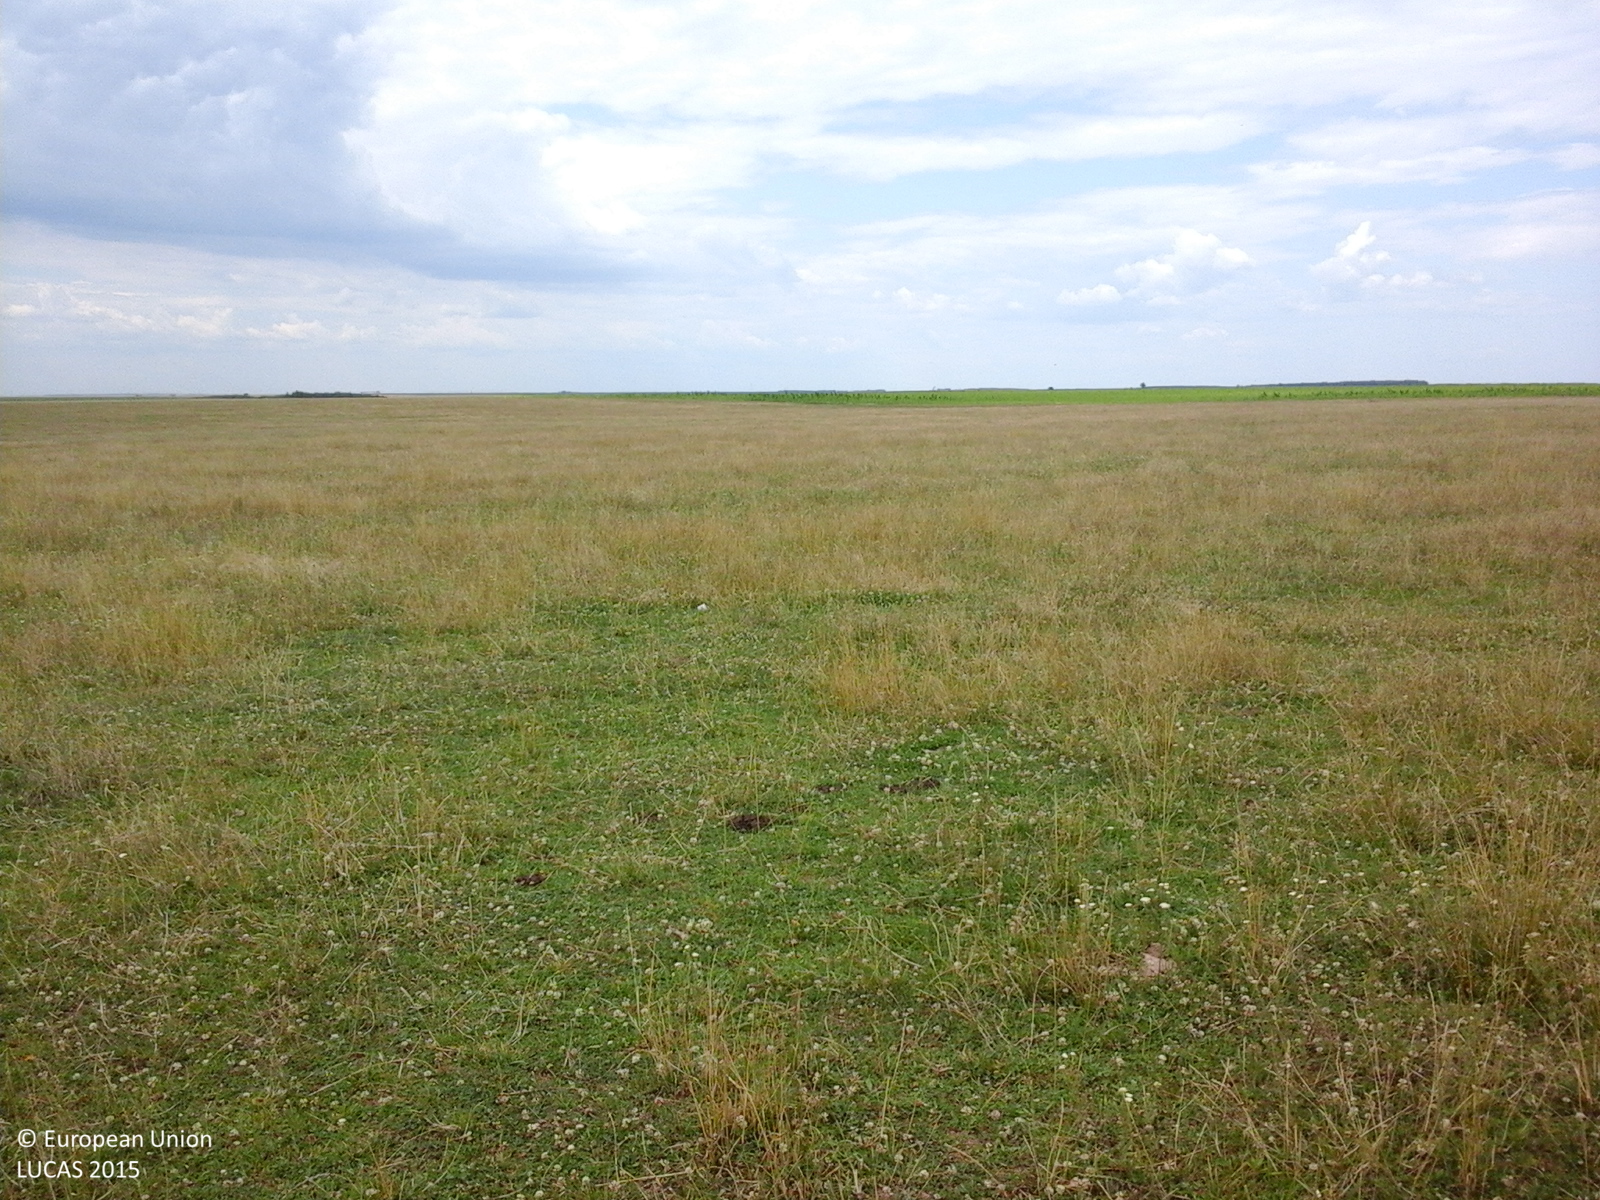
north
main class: Grassland
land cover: Grassland without tree/shrub cover
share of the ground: > 75 %
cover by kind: herbaceous plants 100 %
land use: Agriculture (excluding fallow land and kitchen gardens)
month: July
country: RO
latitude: 44.3389
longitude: 24.7108
